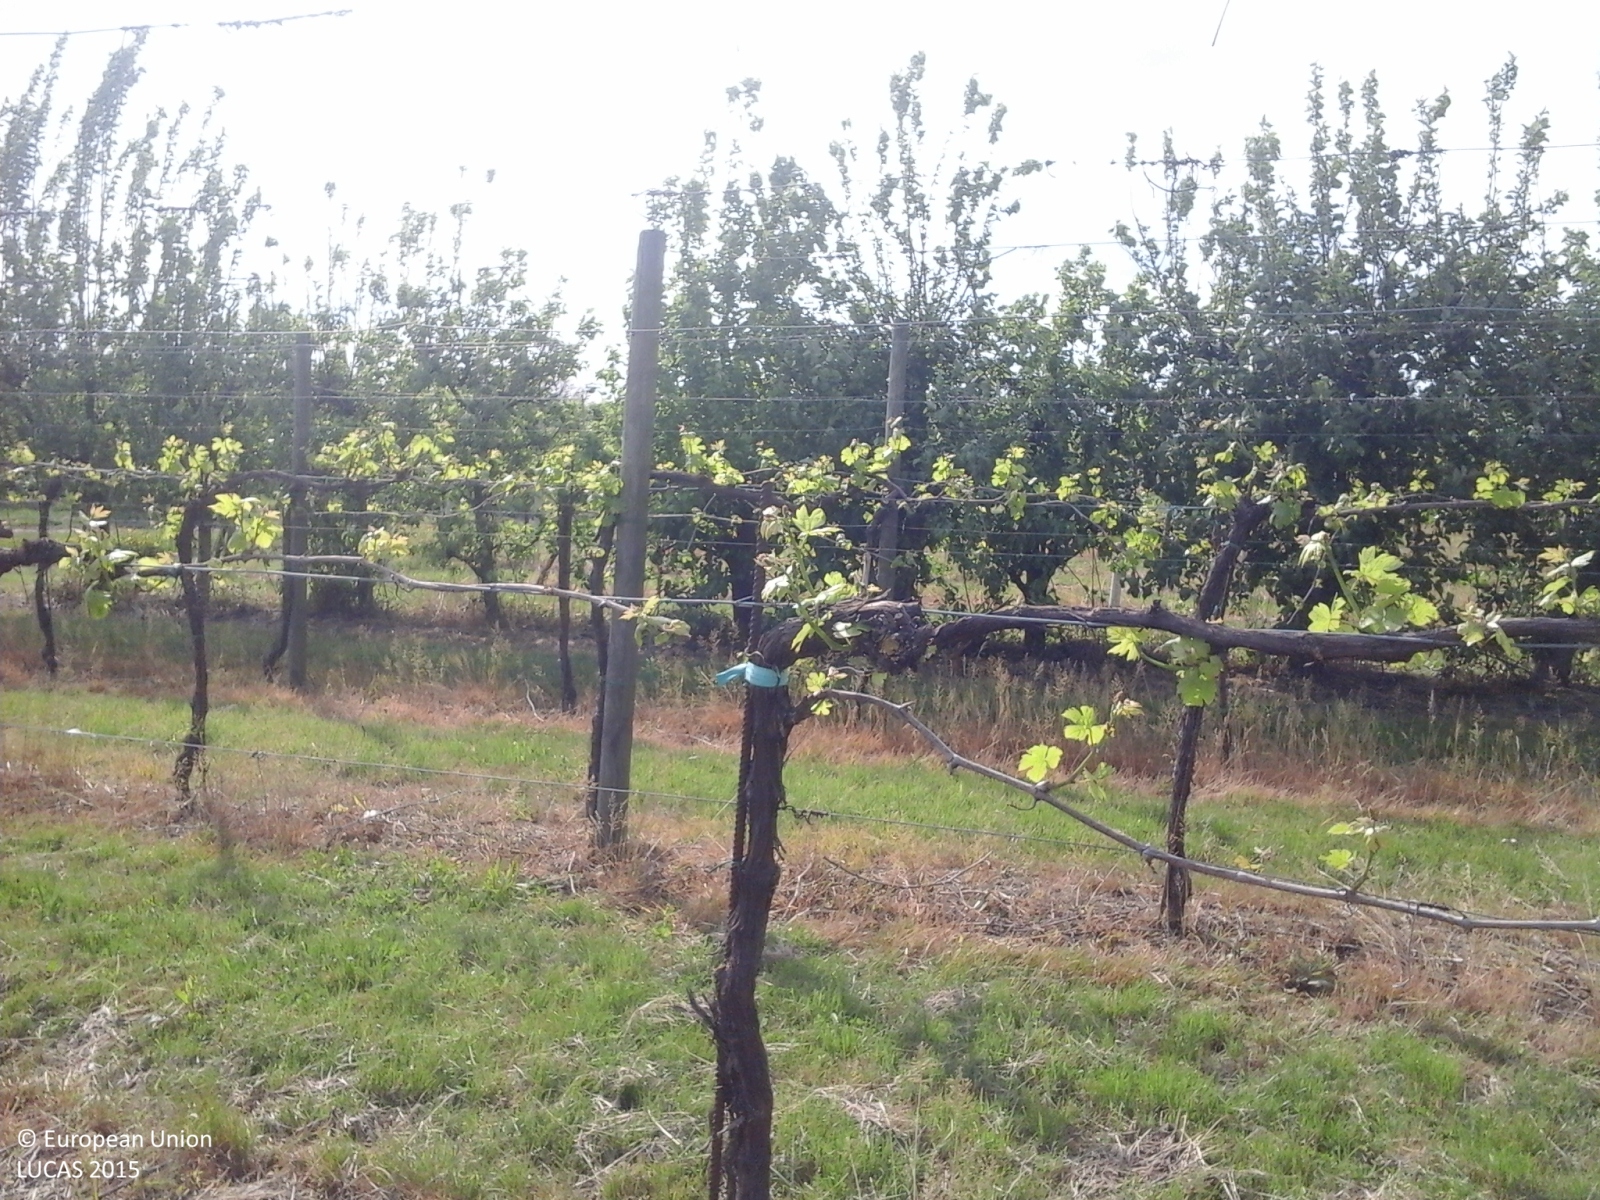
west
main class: Cropland
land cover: Vineyards
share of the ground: 10 - 25 %
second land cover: Grassland without tree/shrub cover
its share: > 75 %
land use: Agriculture (excluding fallow land and kitchen gardens)
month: April
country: IT
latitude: 44.8705
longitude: 10.7958
